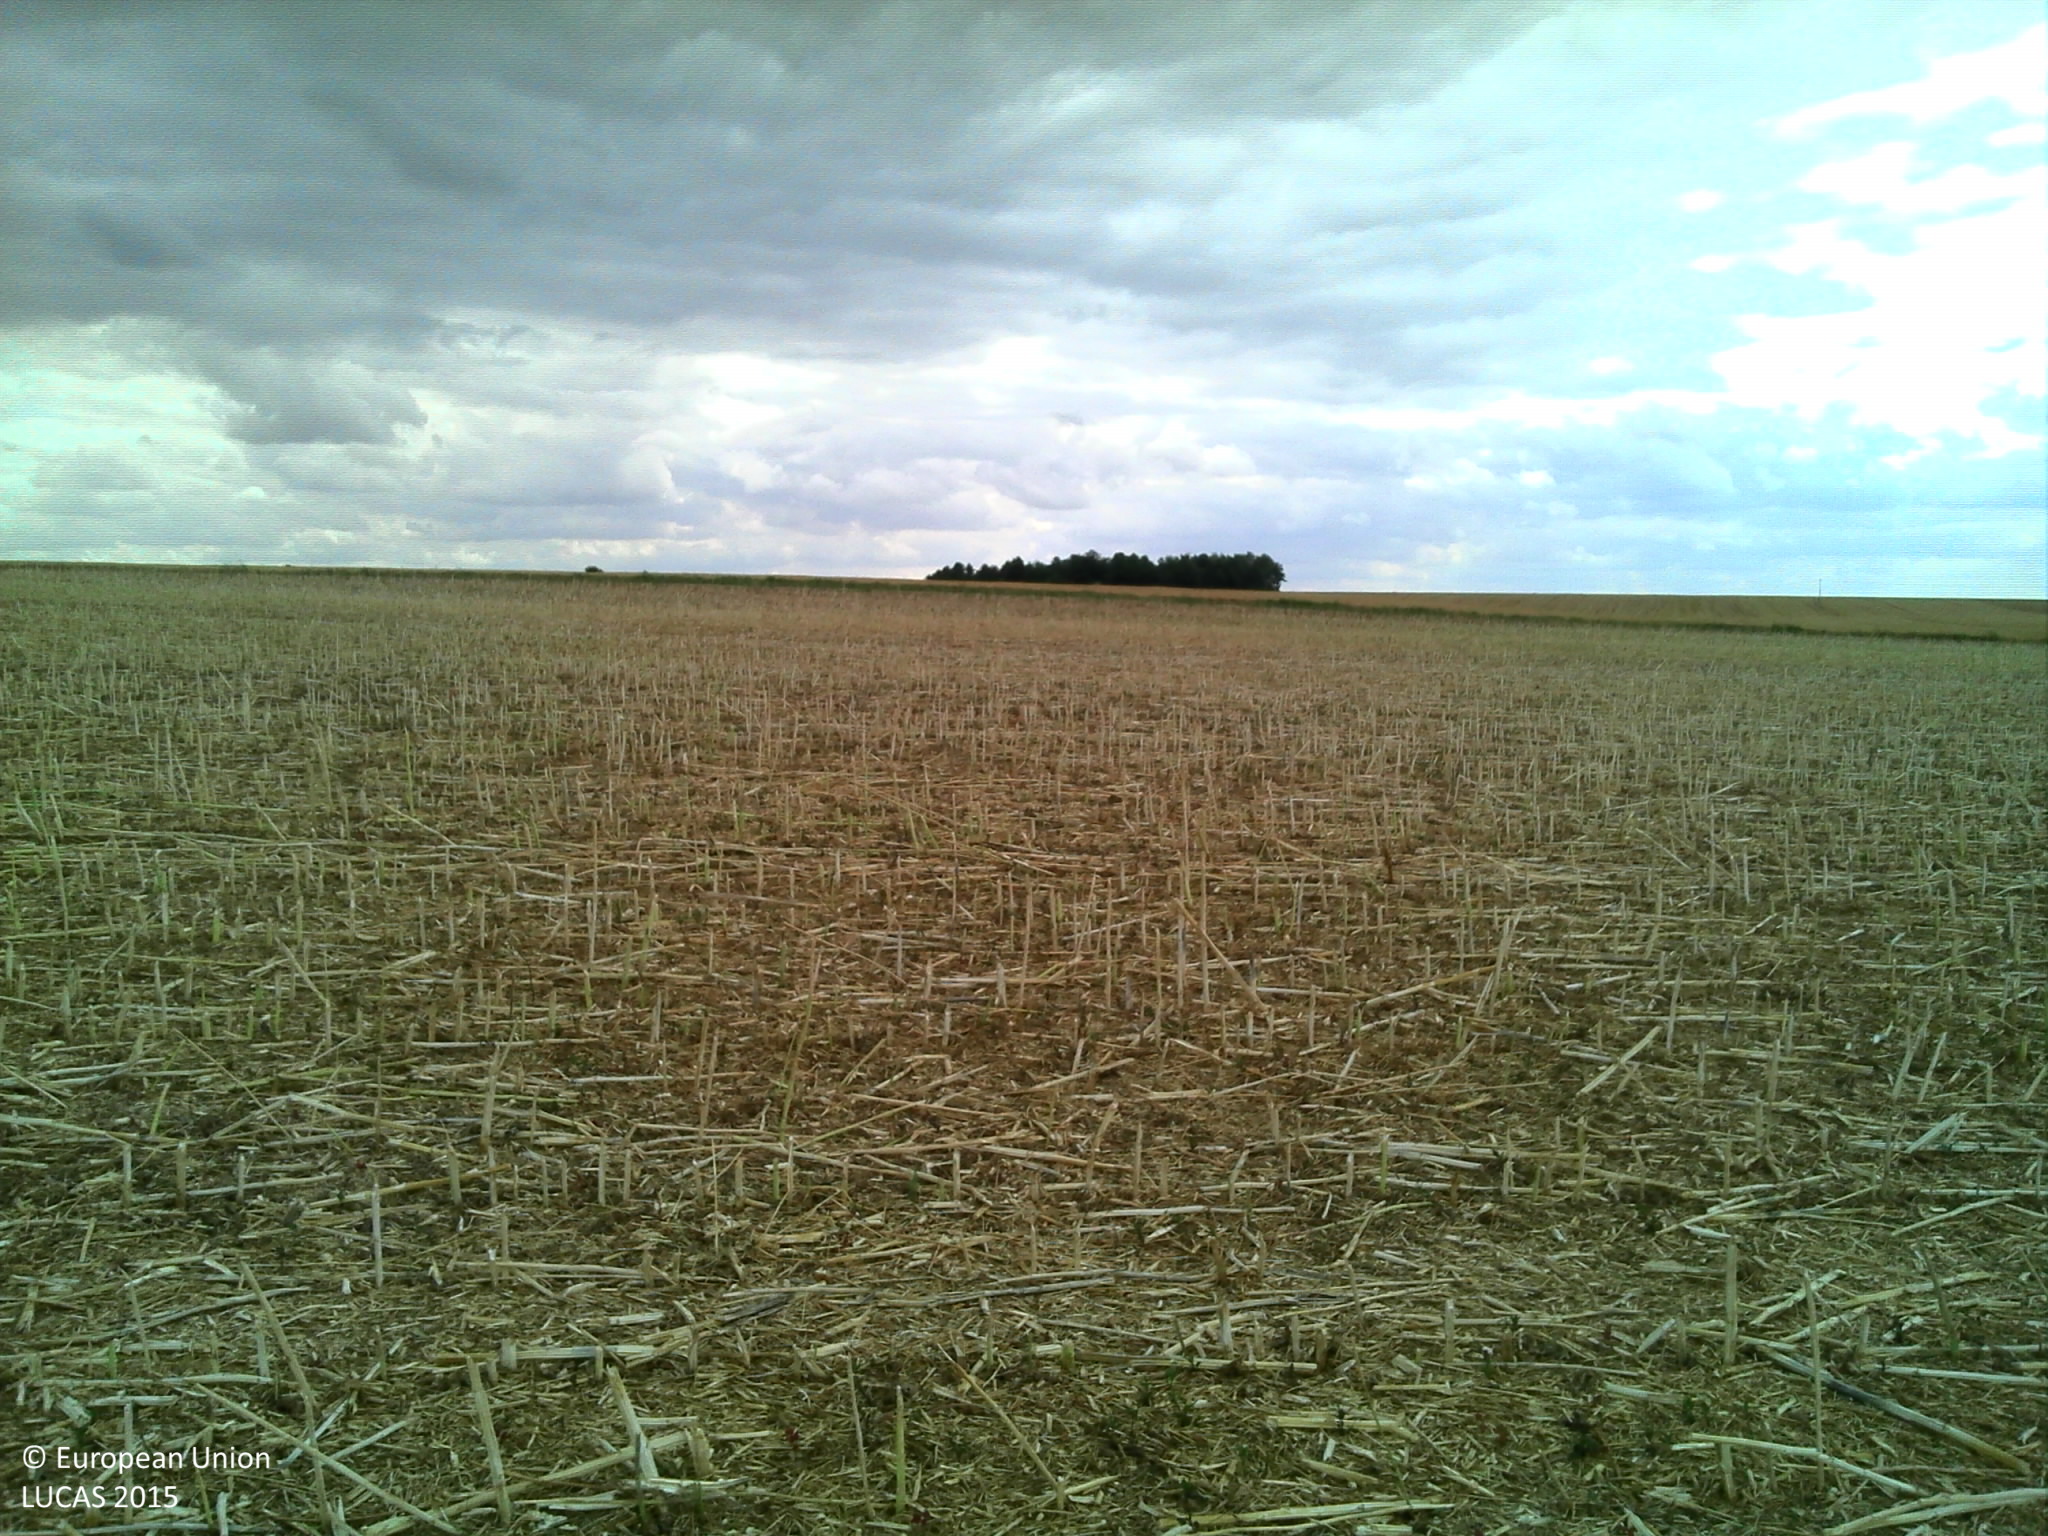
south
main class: Cropland
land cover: Rape and turnip rape
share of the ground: > 75 %
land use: Agriculture (excluding fallow land and kitchen gardens)
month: July
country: FR
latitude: 49.0990
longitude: 4.5594
